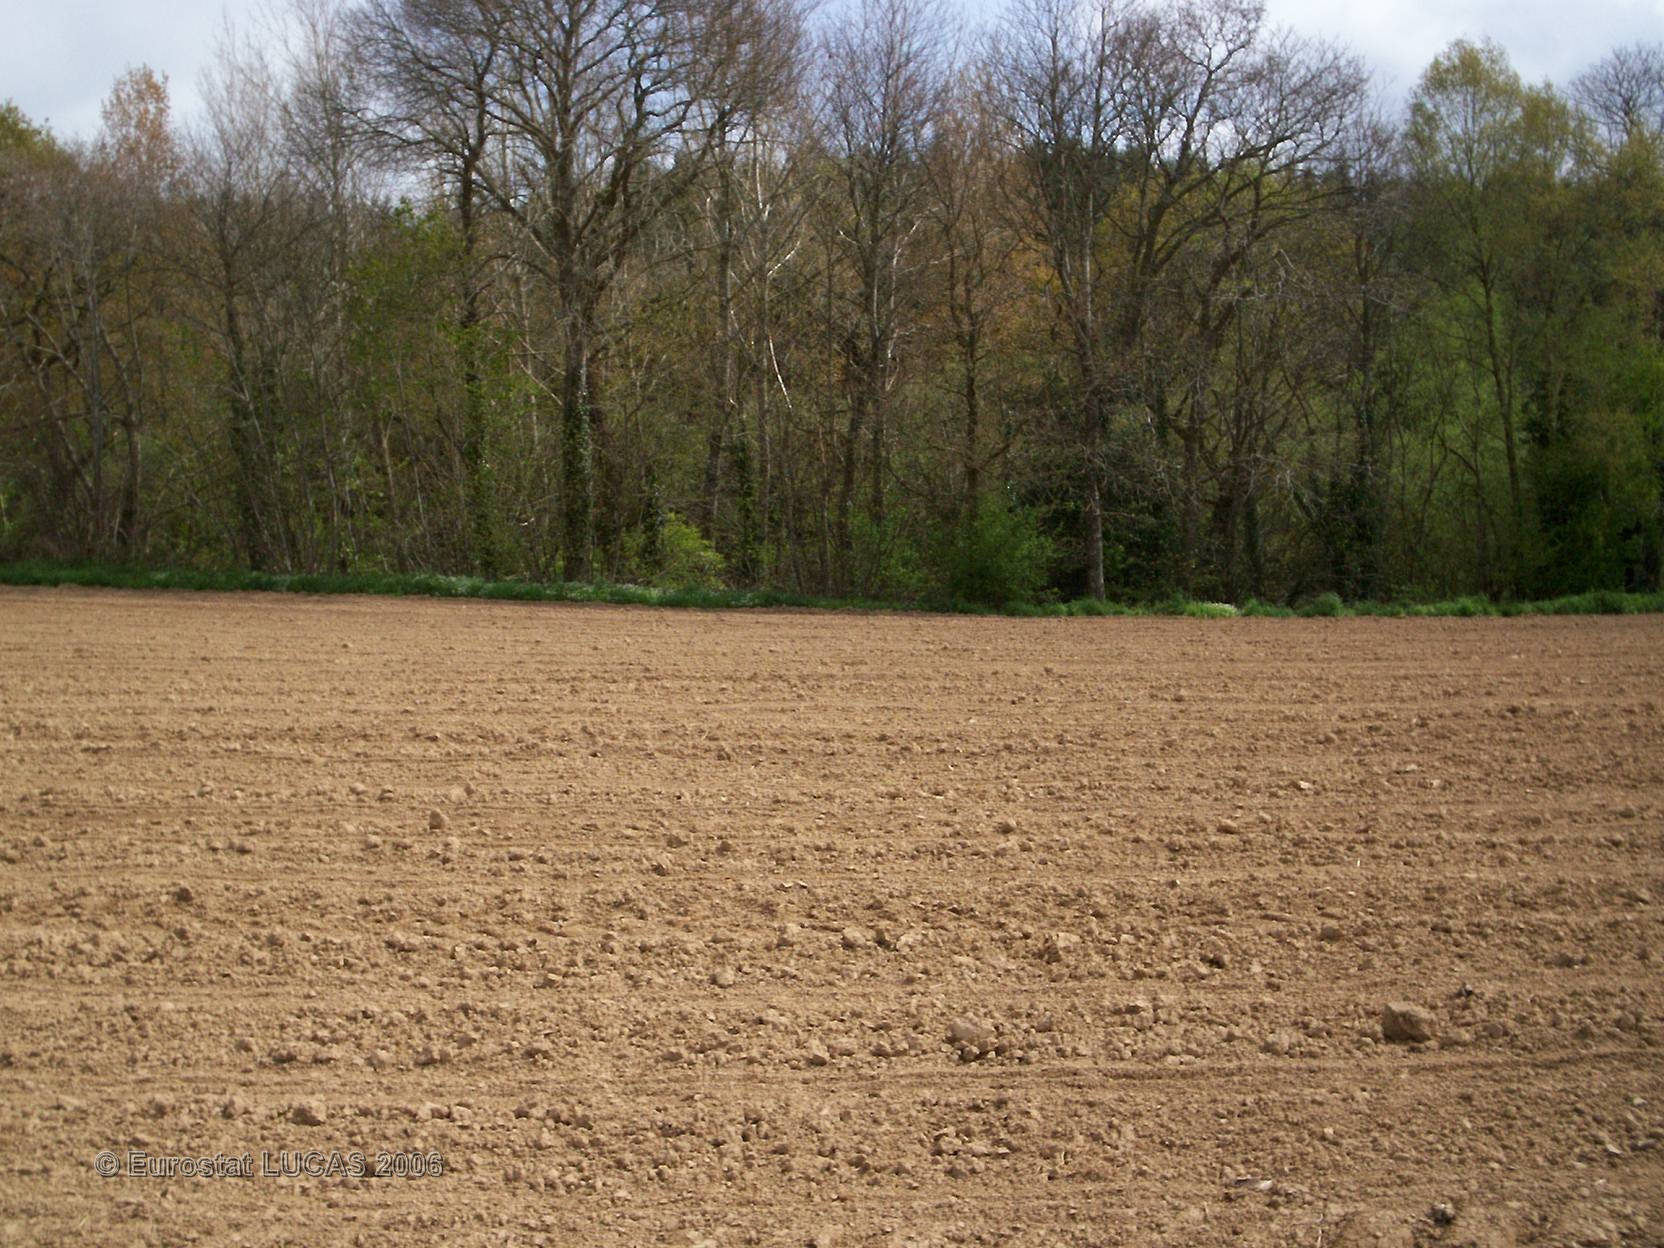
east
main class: Cropland
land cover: Maize
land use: Agriculture (excluding fallow land and kitchen gardens)
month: June
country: FR
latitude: 48.3683
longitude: -2.4660
